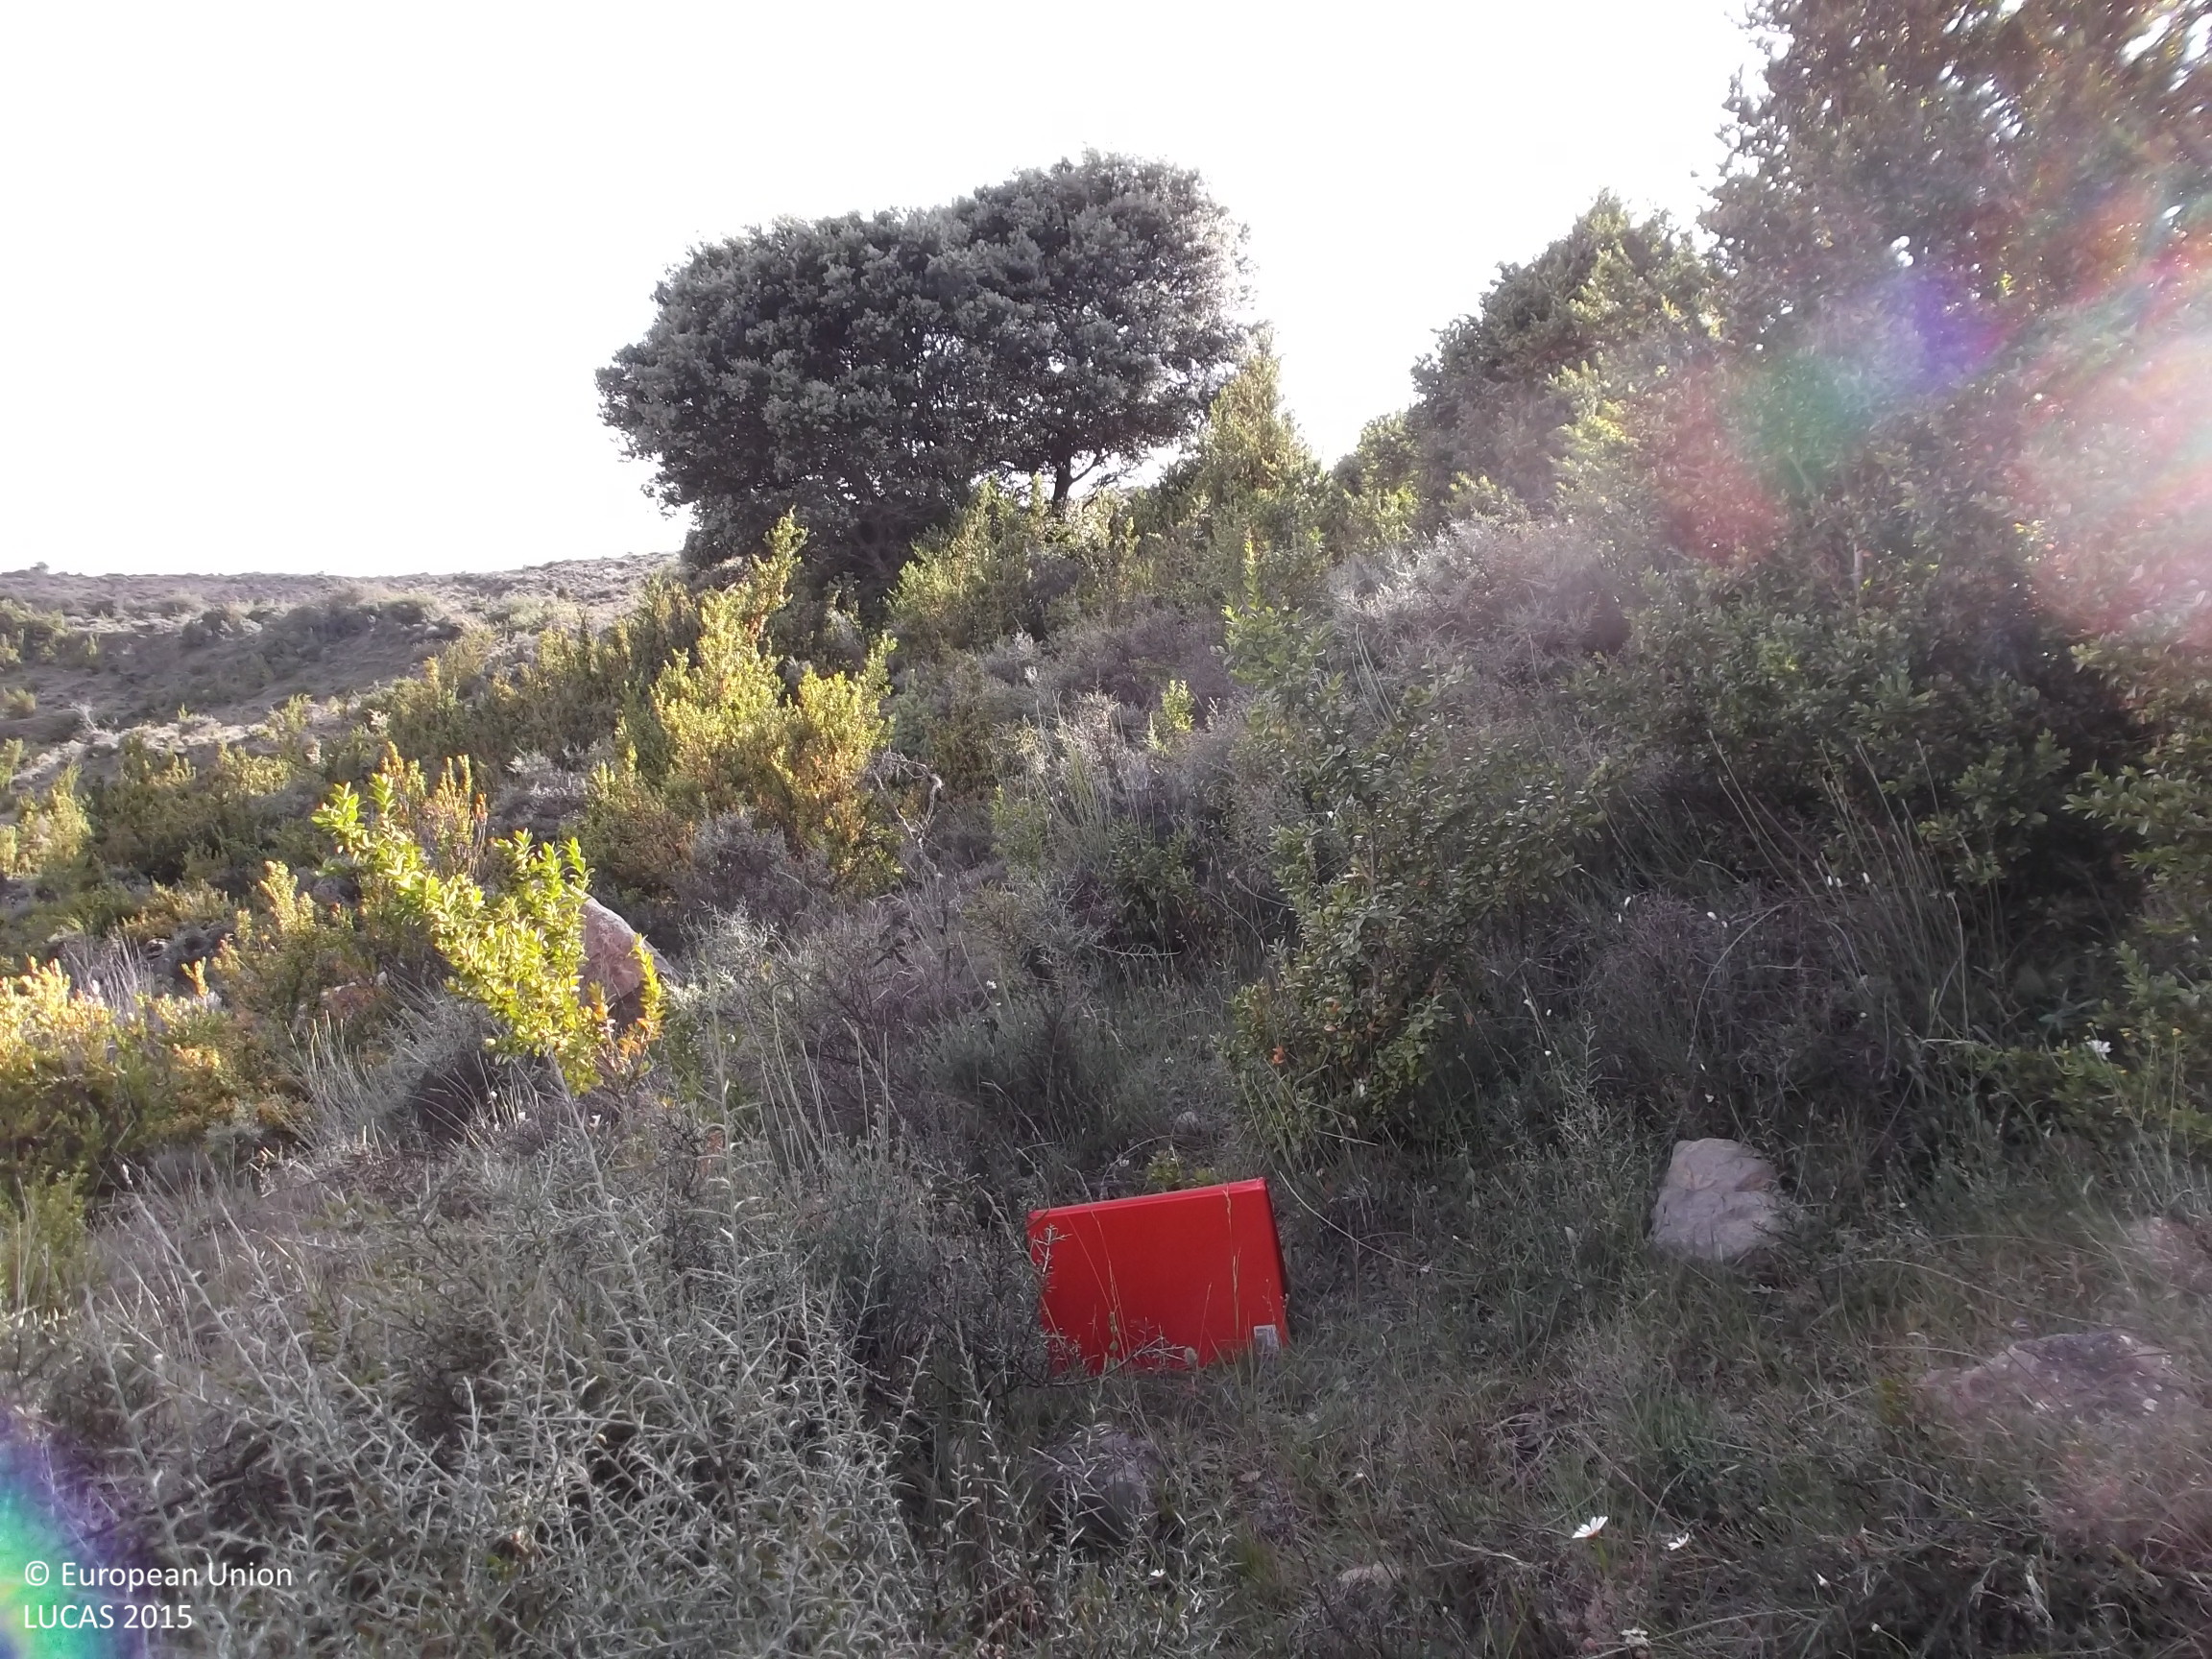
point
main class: Shrubland
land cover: Shrubland with sparse tree cover
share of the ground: 50 - 75 %
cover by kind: shrubs 60 %, herbaceous plants 30 %, broadleaved forest trees 5 %, unconsolidated bare surface 5 %
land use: Agriculture (excluding fallow land and kitchen gardens)
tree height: < 5 m
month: June
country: ES
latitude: 42.3169
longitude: -2.3329
